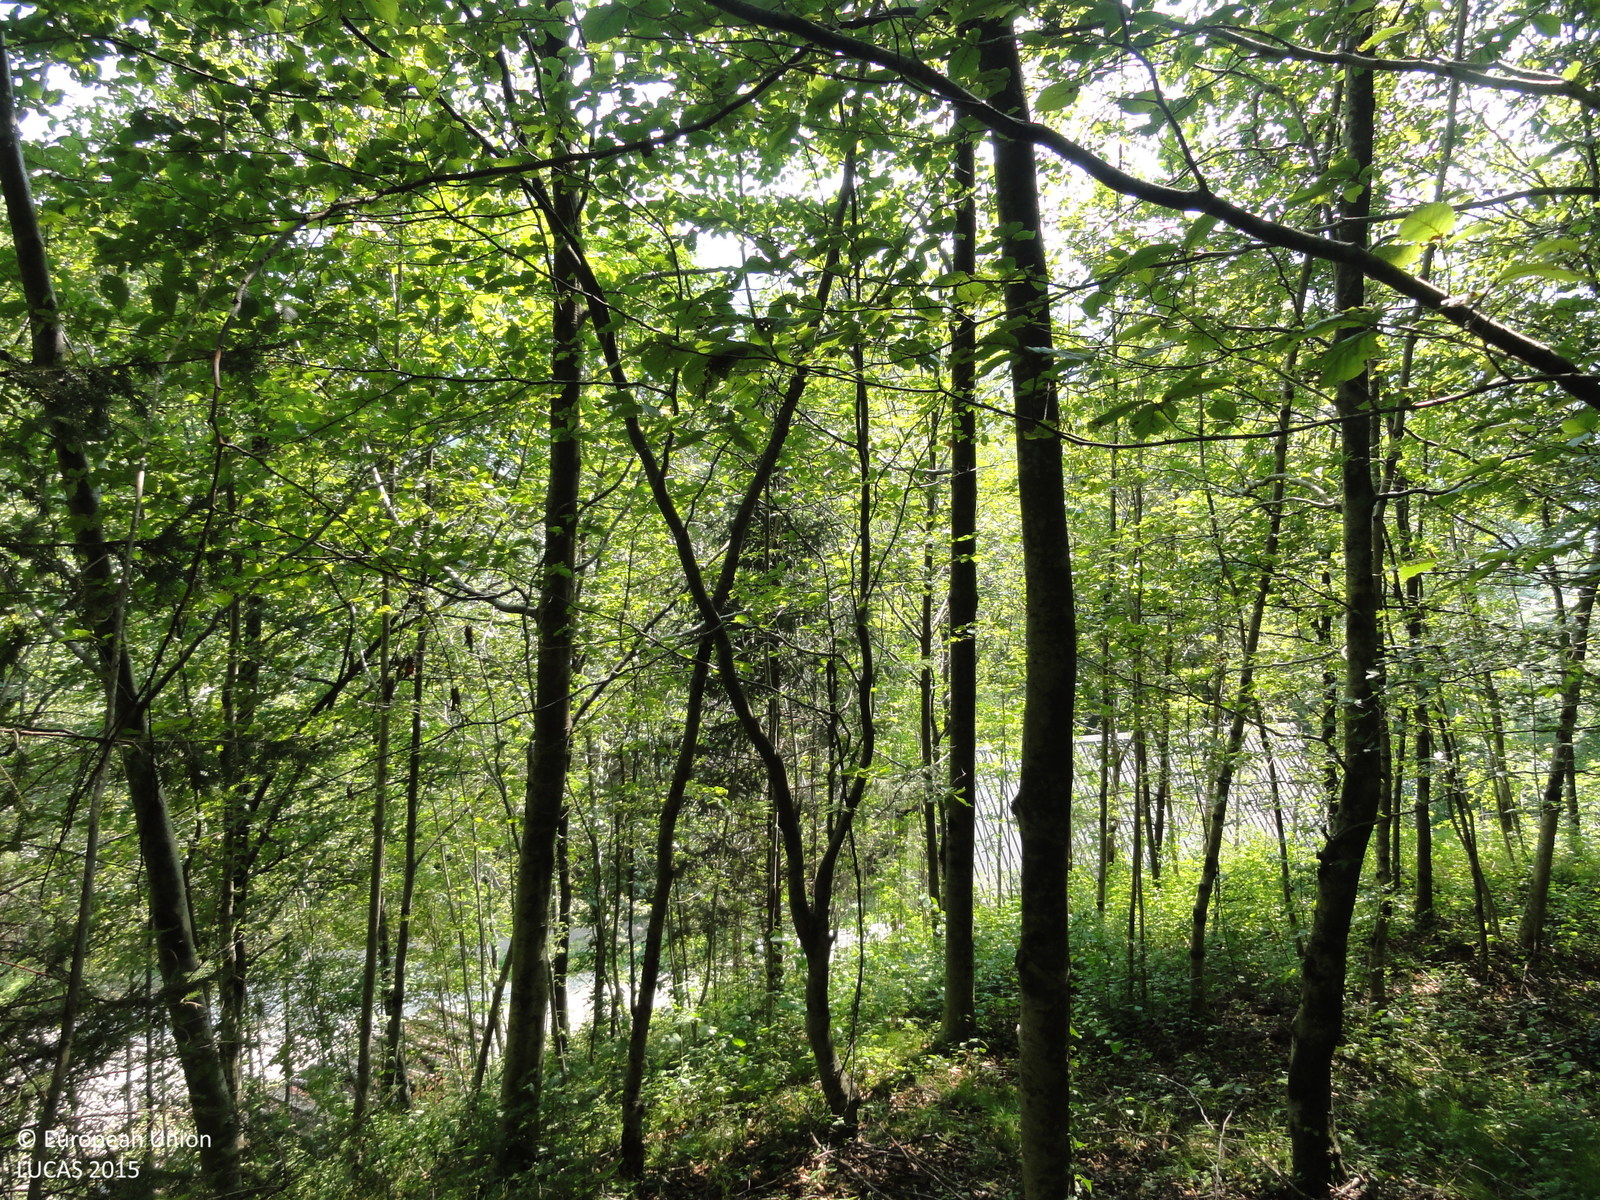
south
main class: Woodland
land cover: Broadleaved woodland
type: beech forest
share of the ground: > 75 %
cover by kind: broadleaved forest trees 90 %, coniferous forest trees 10 %
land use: Forestry
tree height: > 5 m
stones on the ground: < 10 %
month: August
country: SI
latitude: 46.2361
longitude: 13.6146
